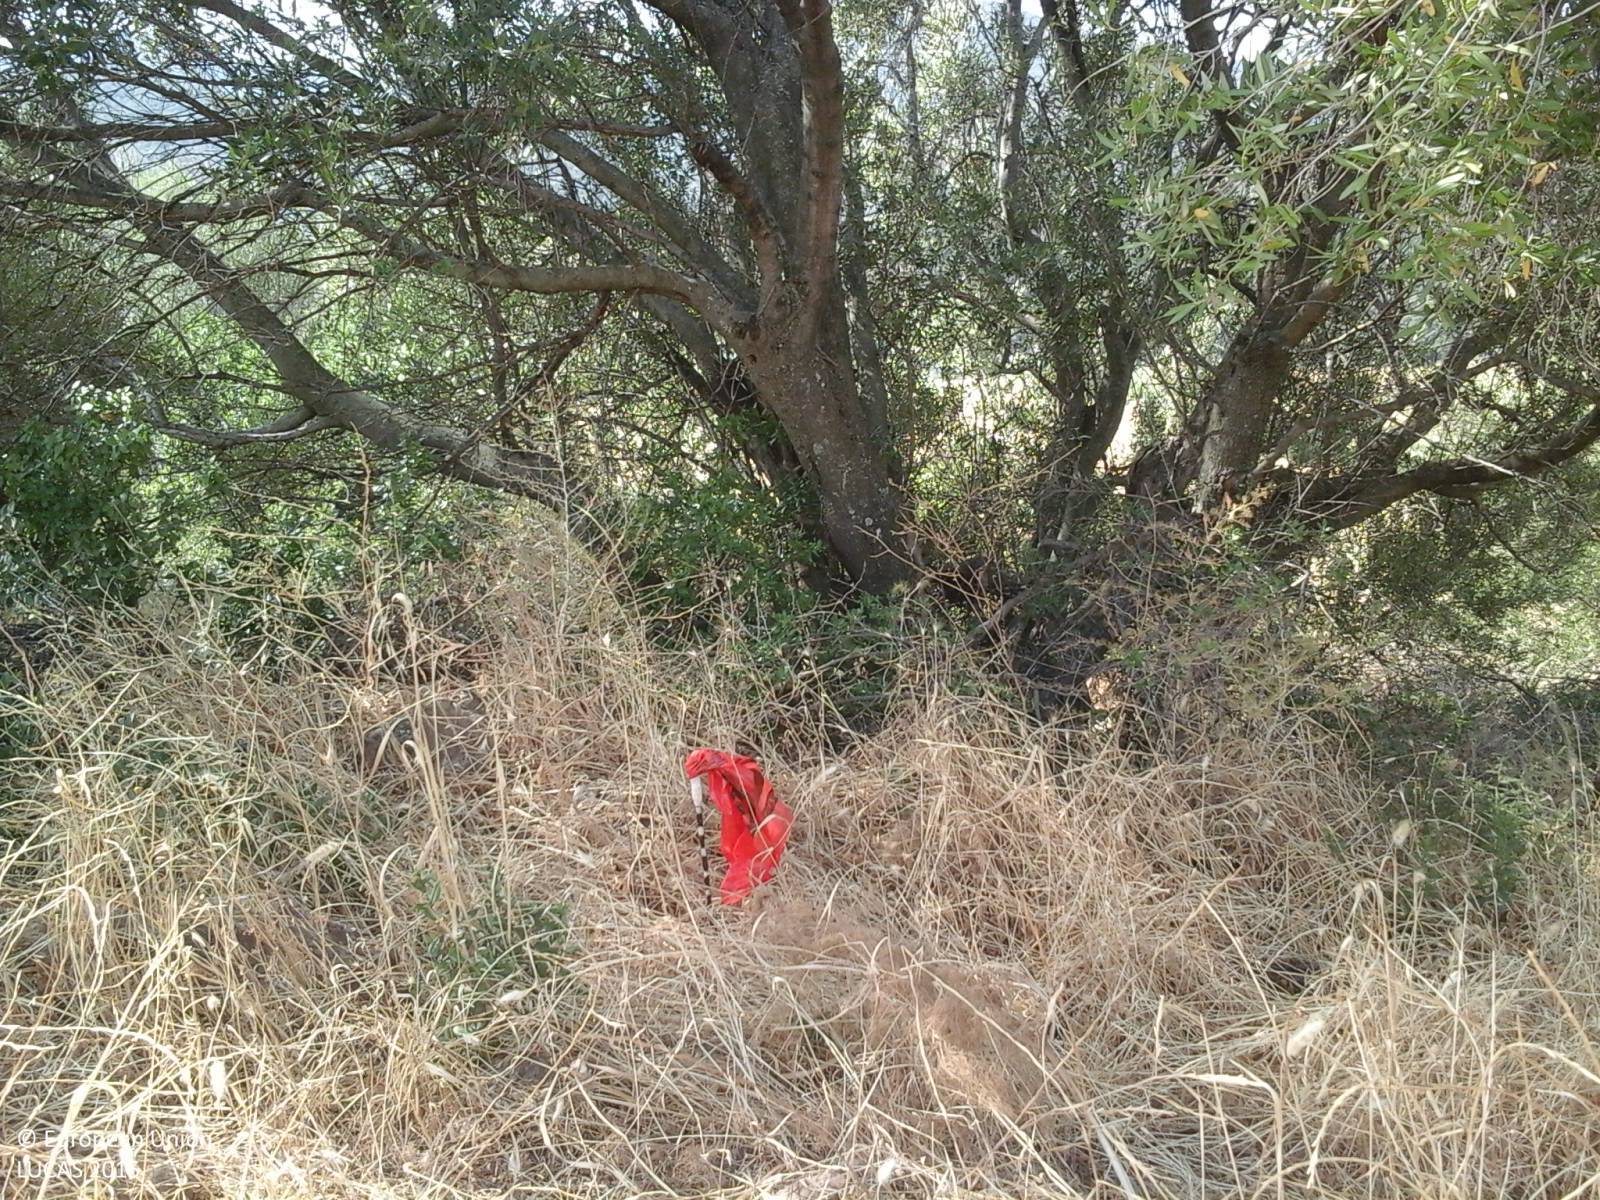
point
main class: Woodland
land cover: Broadleaved woodland
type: broadleaved evergreen forest
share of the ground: > 75 %
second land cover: Temporary grasslands
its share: > 75 %
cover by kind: broadleaved forest trees 95 %, herbaceous plants 5 %
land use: Forestry
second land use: Agriculture (excluding fallow land and kitchen gardens)
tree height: > 5 m
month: July
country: IT
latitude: 40.6283
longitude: 9.5647
